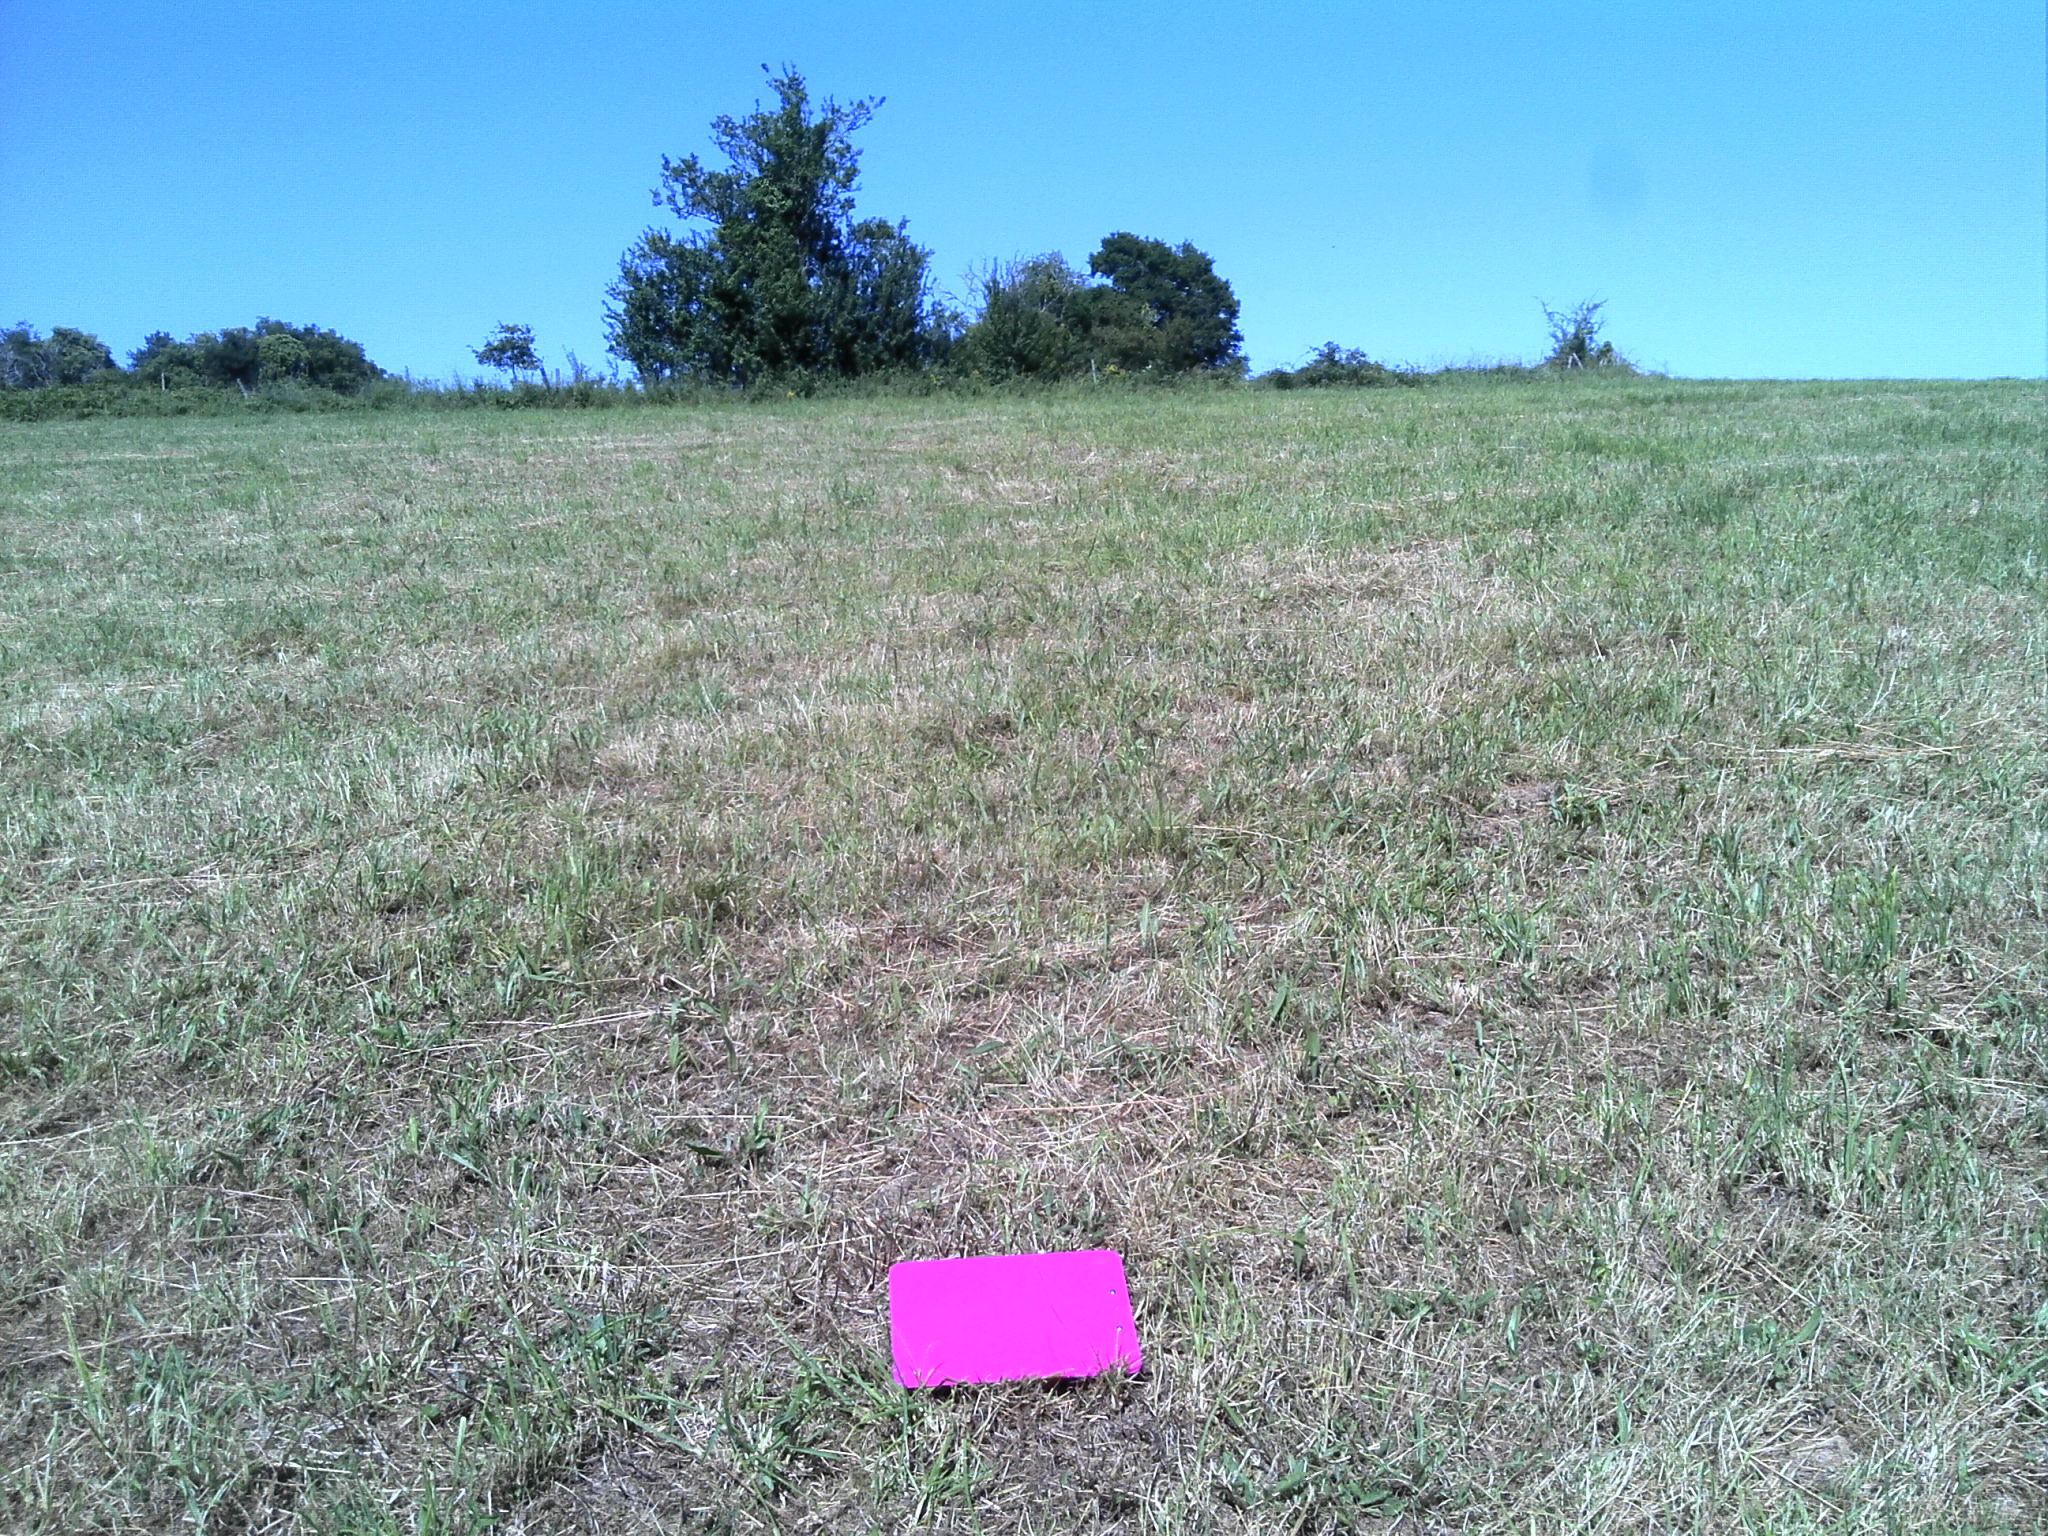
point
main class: Grassland
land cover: Grassland without tree/shrub cover
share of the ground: > 75 %
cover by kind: herbaceous plants 100 %
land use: Agriculture (excluding fallow land and kitchen gardens)
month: June
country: FR
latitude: 46.4303
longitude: 1.5182
